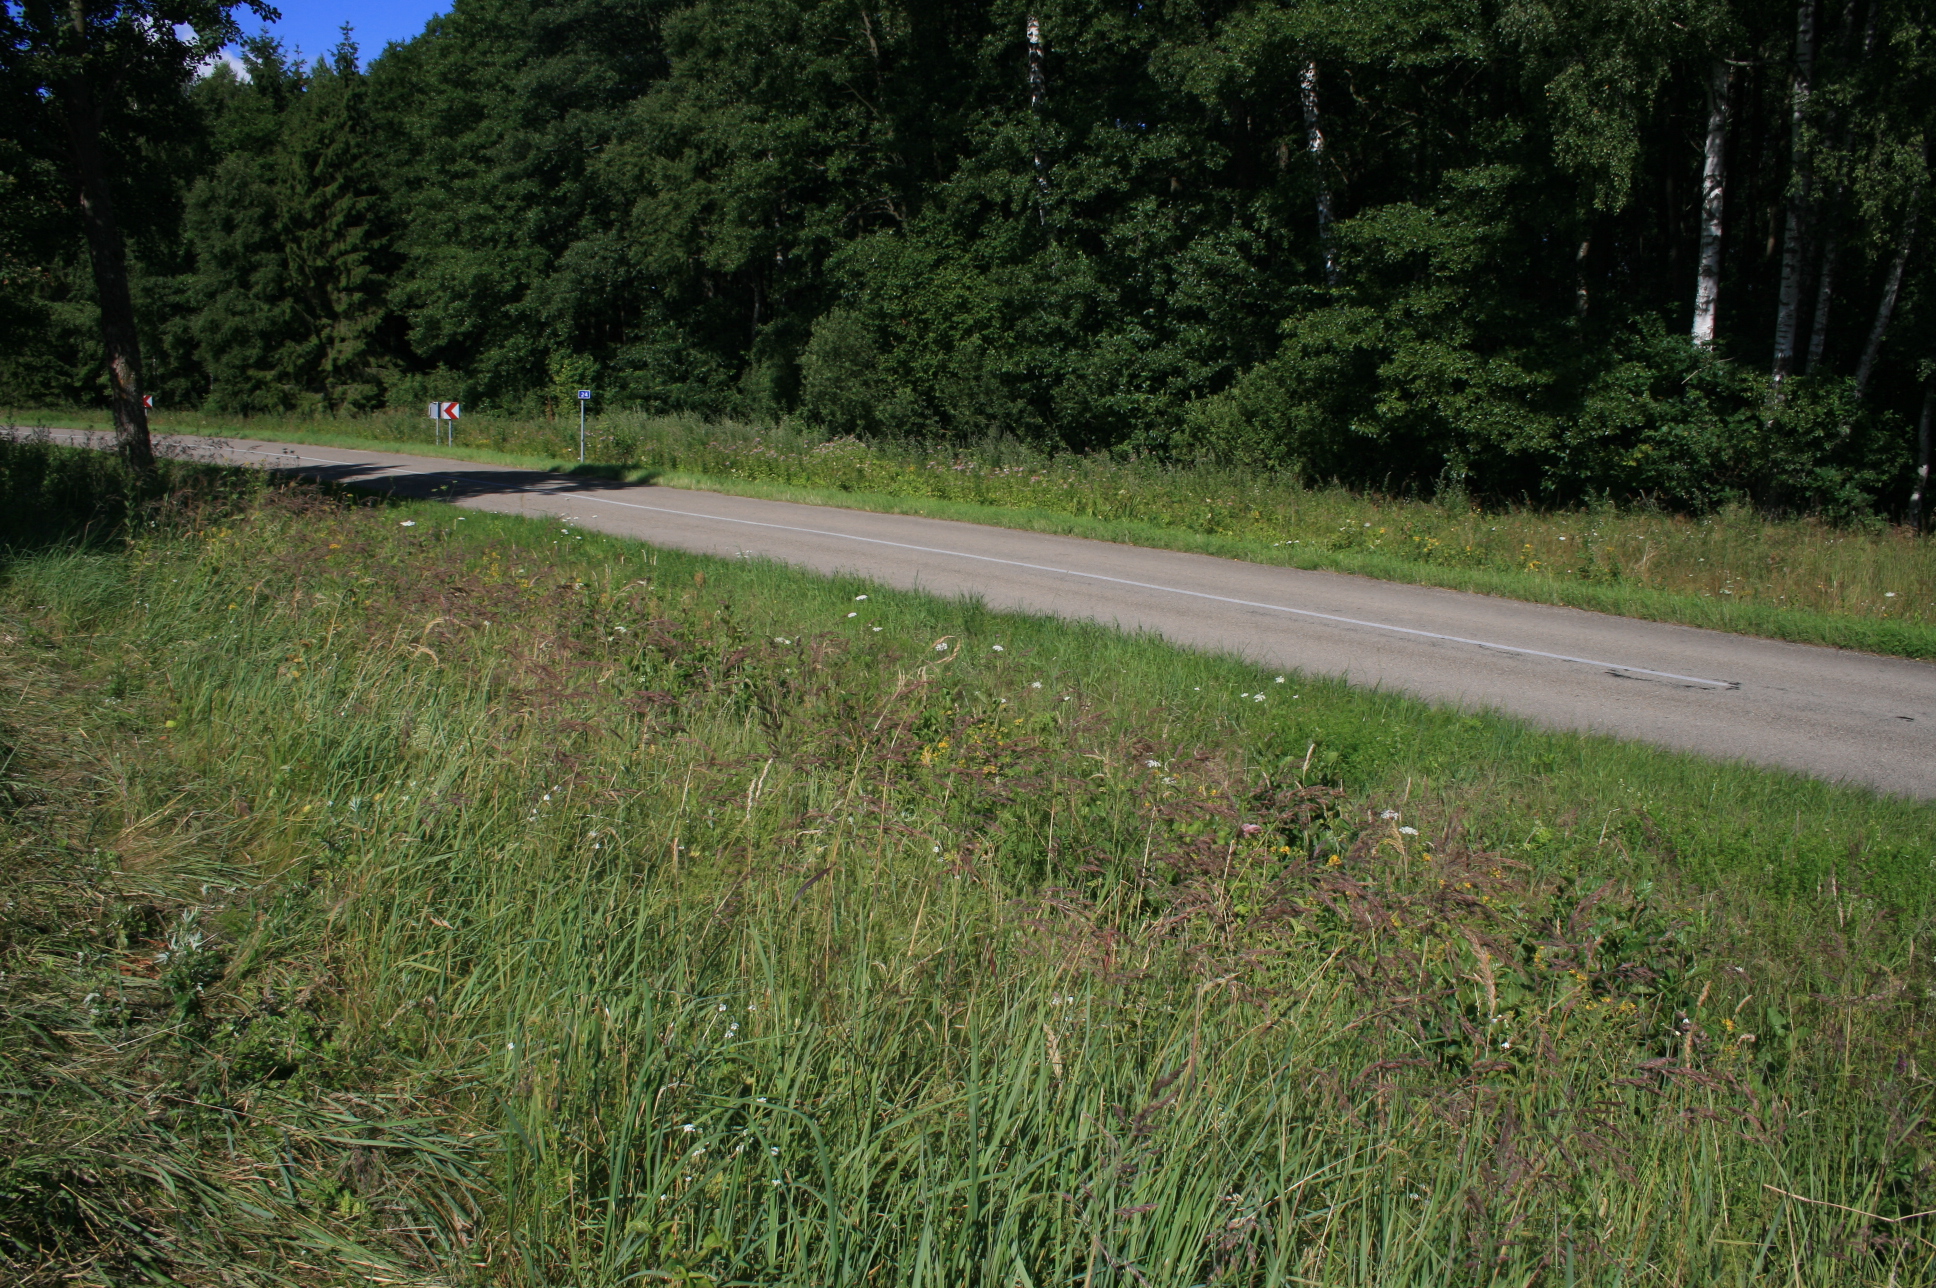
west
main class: Grassland
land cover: Spontaneously vegetated surfaces
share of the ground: > 75 %
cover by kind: herbaceous plants 100 %
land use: Agriculture (excluding fallow land and kitchen gardens)
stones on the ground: < 10 %
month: July
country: LT
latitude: 55.3839
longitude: 21.2336
